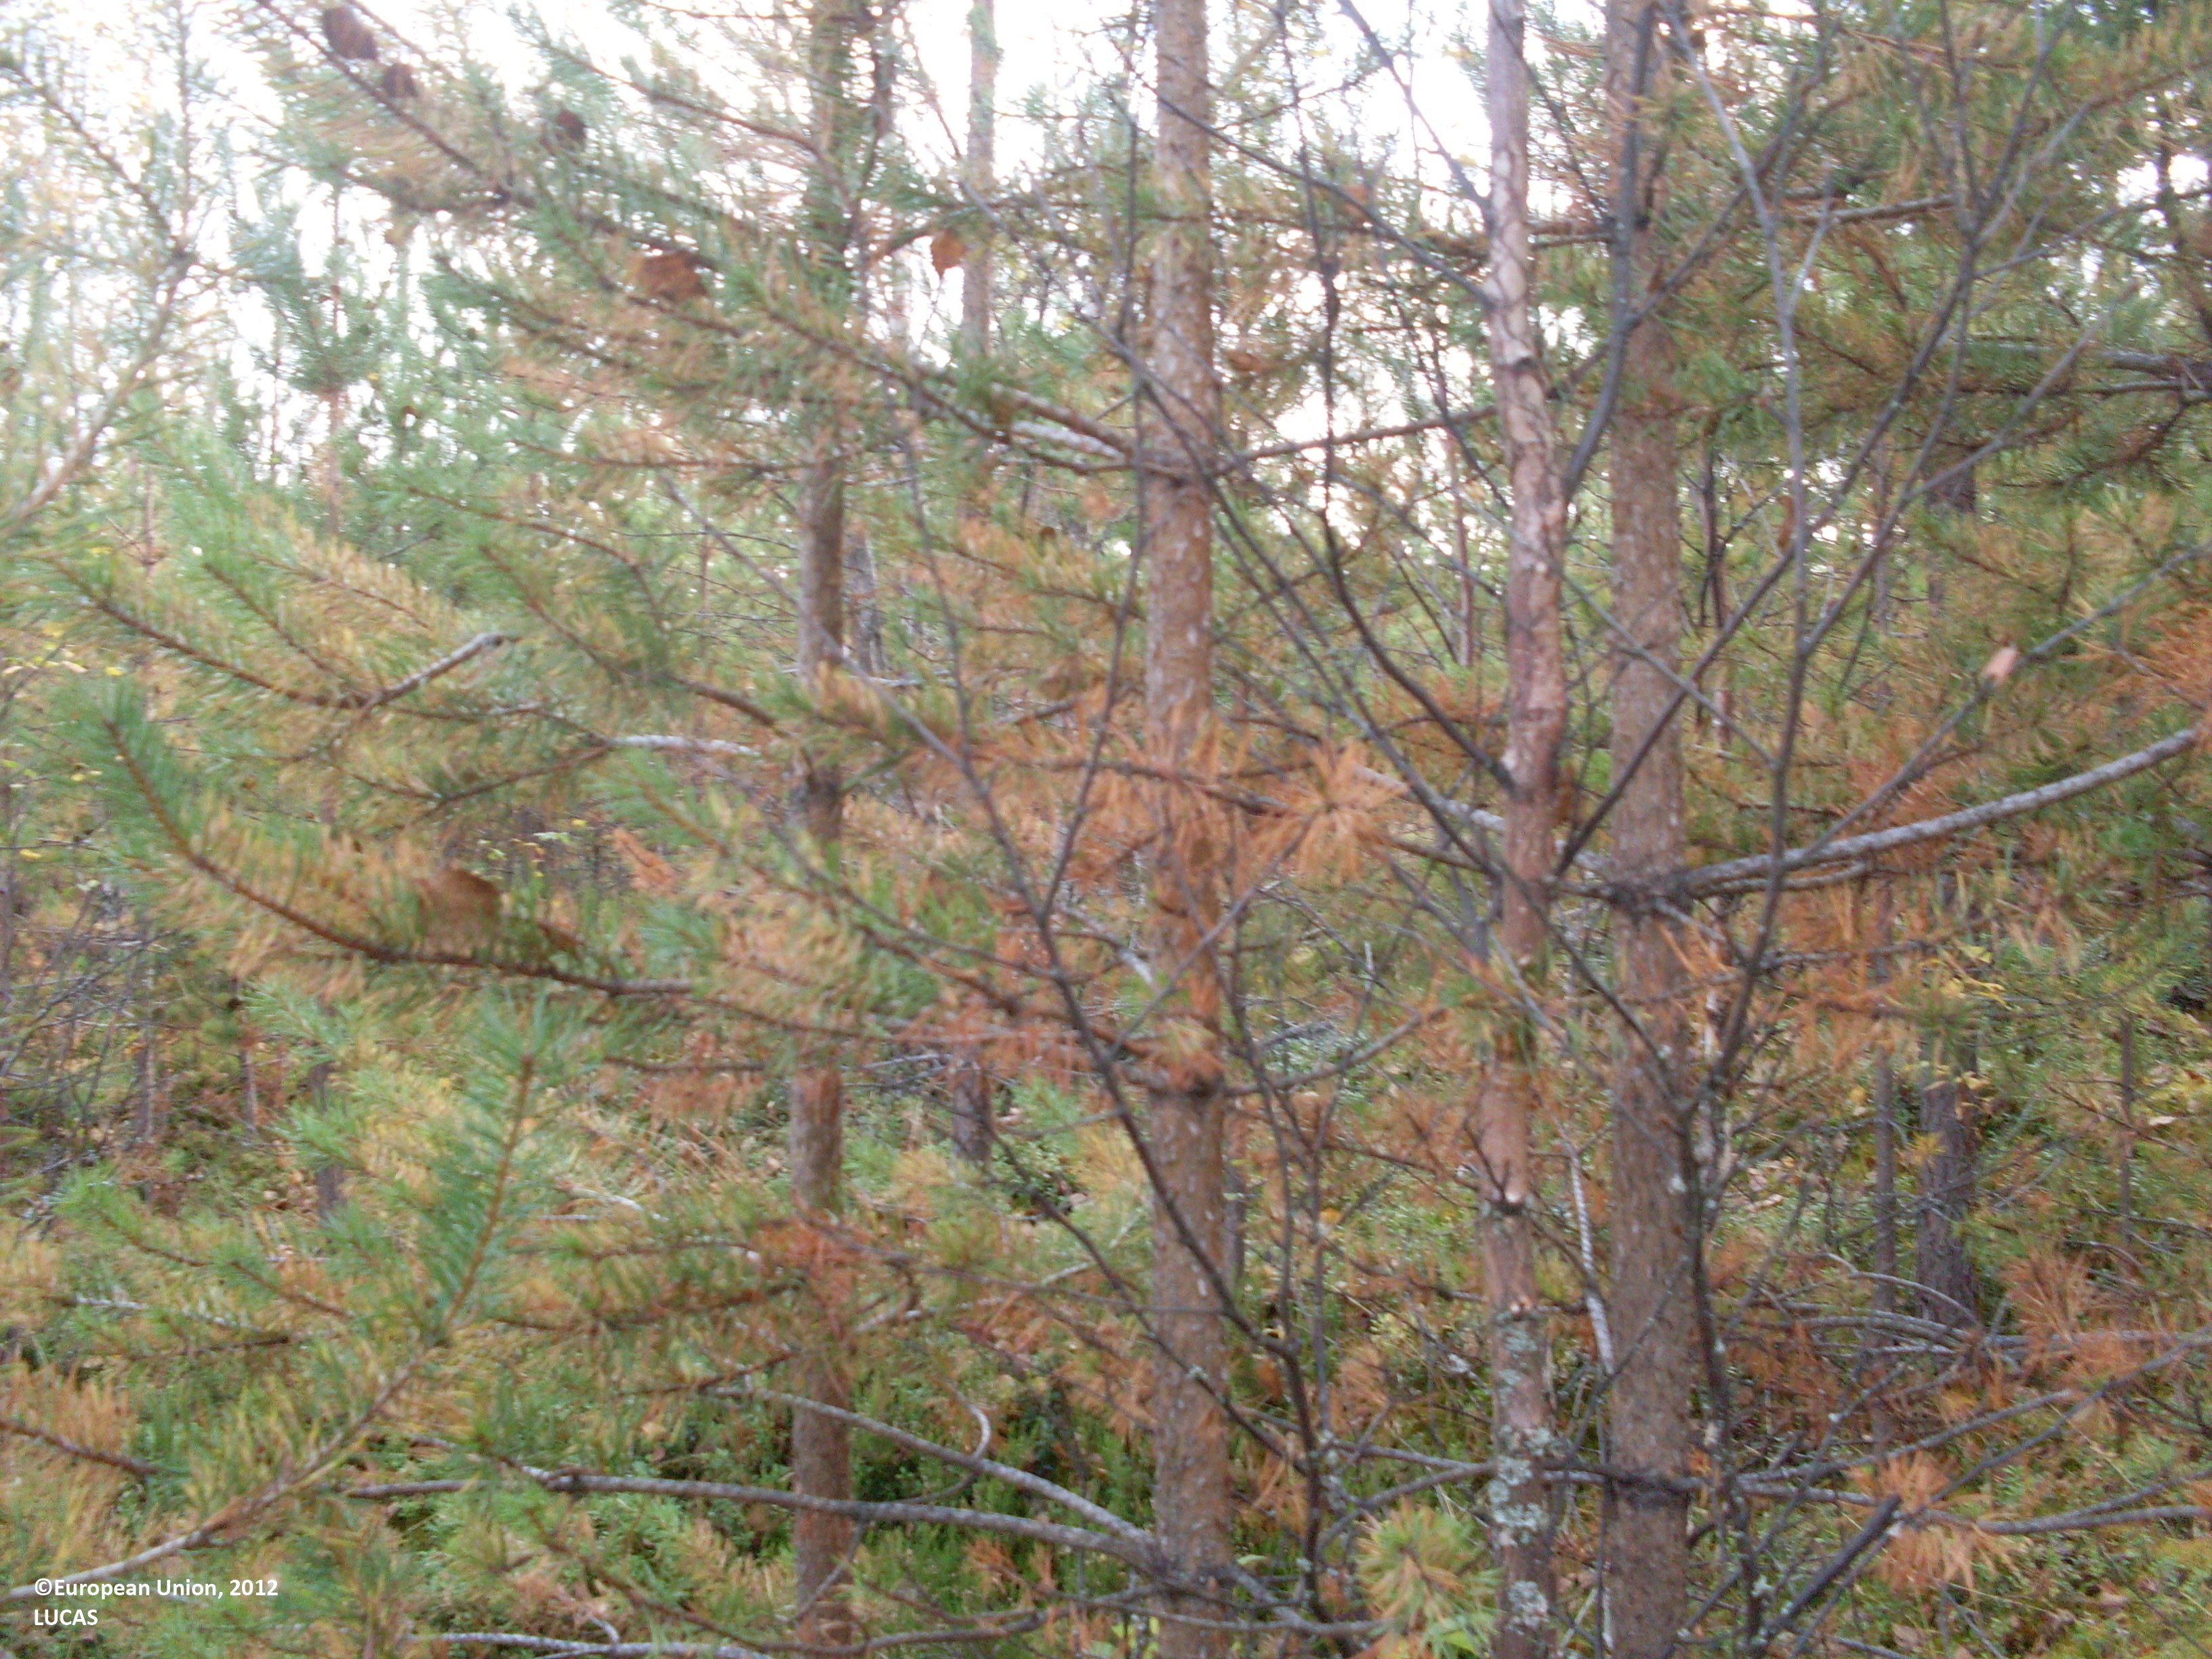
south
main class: Woodland
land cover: Pine dominated coniferous woodland
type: boreal forest
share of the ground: 50 - 75 %
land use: Forestry
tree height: < 5 m
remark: Nursery
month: September
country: FI
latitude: 64.4112
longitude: 28.3716
